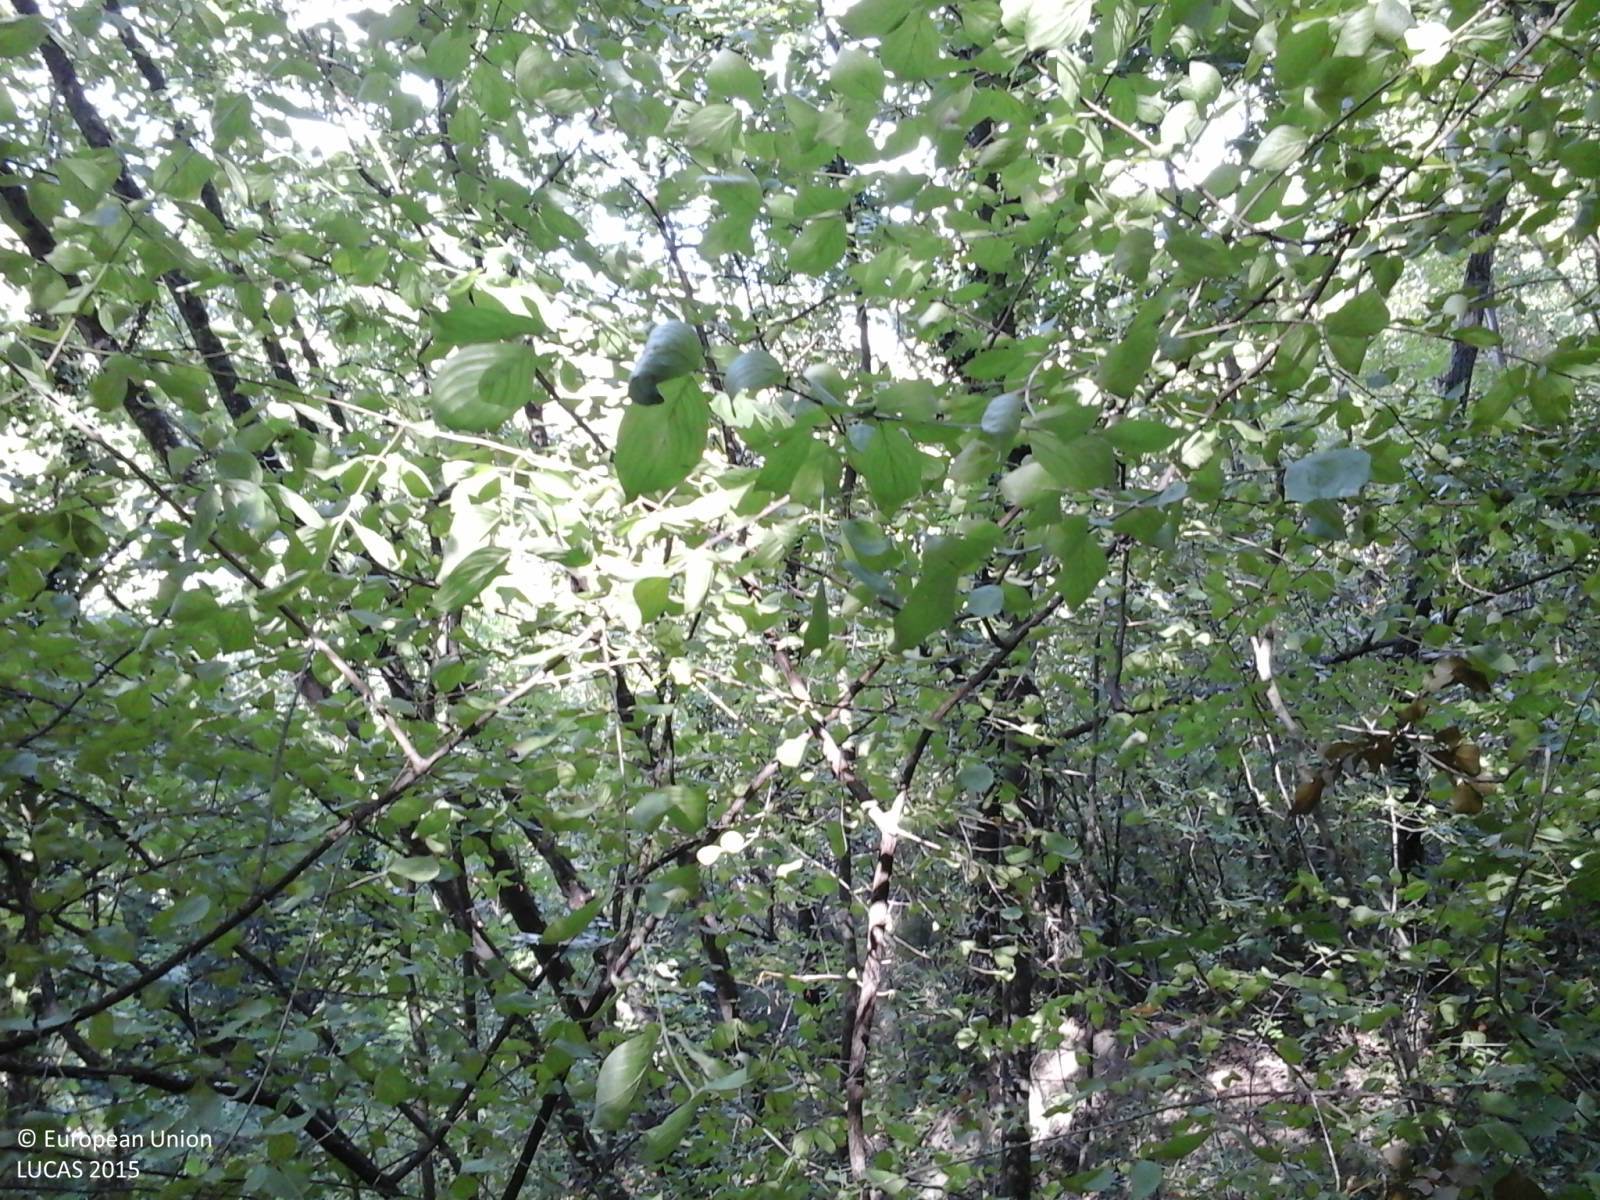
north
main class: Woodland
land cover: Broadleaved woodland
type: thermophilous deciduous forest
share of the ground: > 75 %
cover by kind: broadleaved forest trees 100 %
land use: Forestry
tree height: > 5 m
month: September
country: IT
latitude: 42.9290
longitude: 12.5532
